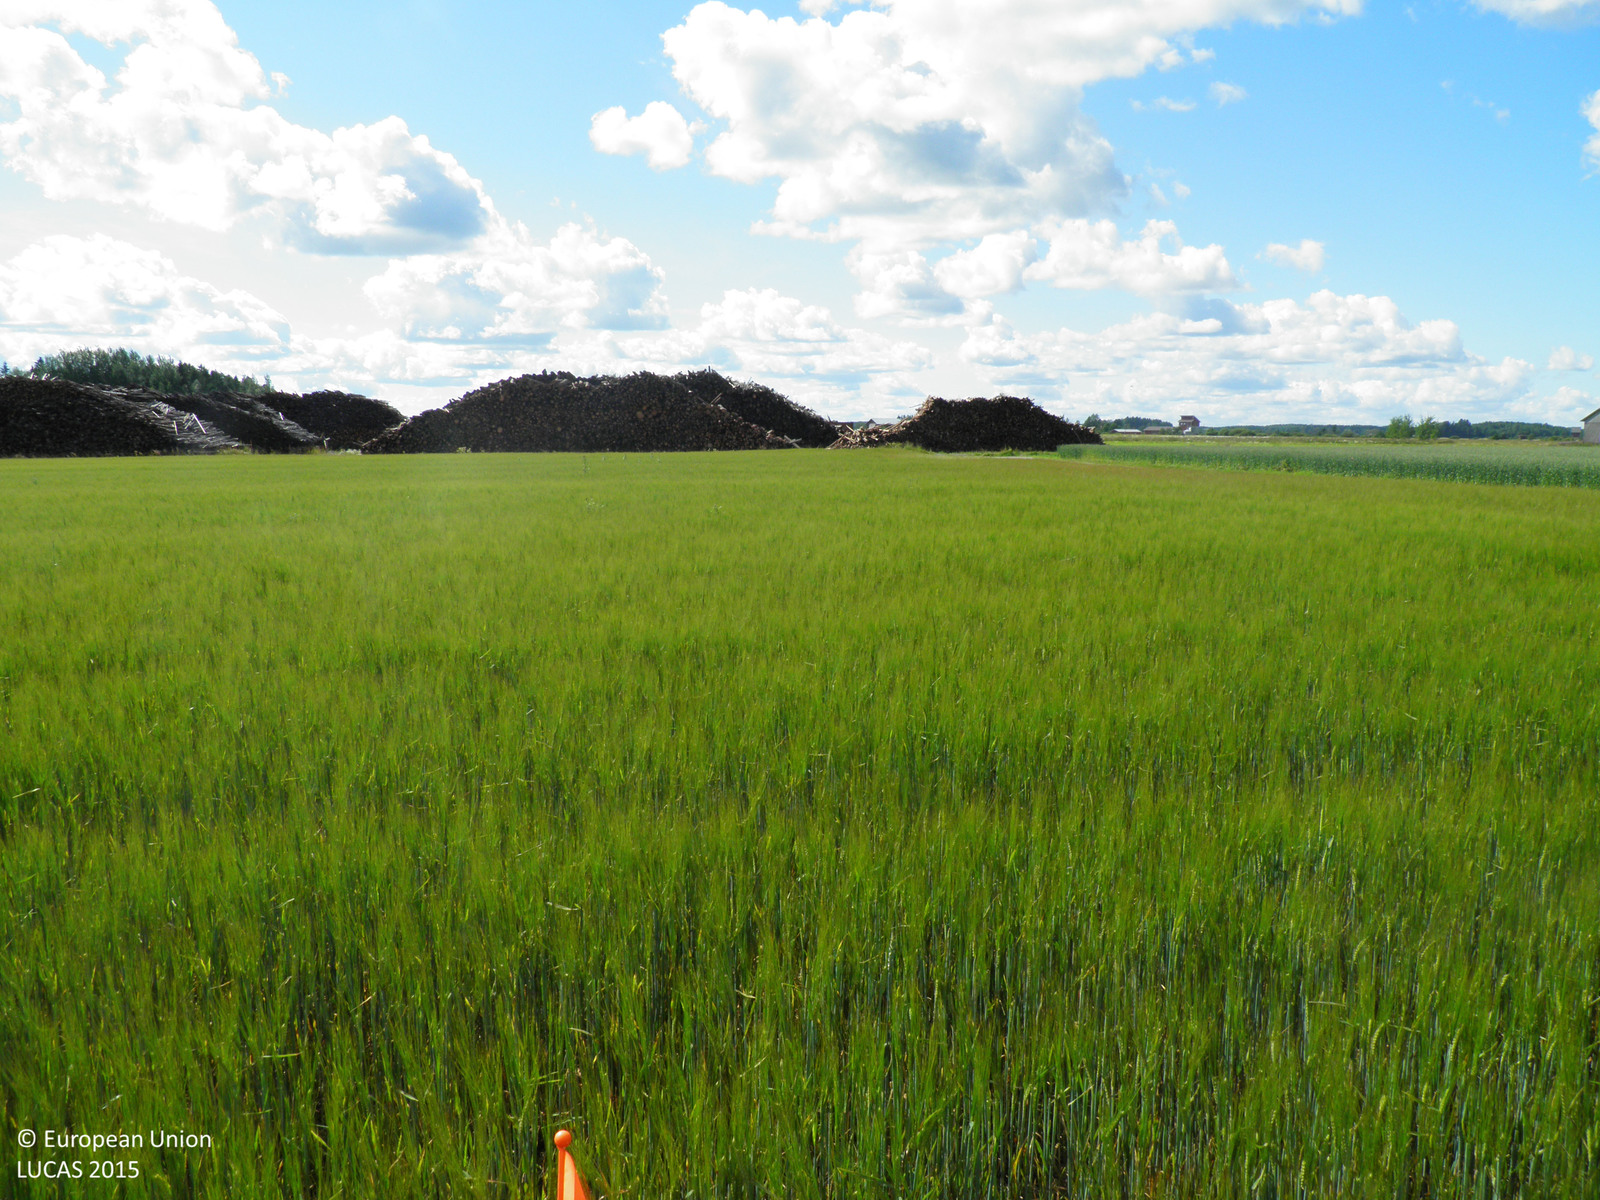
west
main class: Cropland
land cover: Barley
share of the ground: > 75 %
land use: Agriculture (excluding fallow land and kitchen gardens)
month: August
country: FI
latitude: 60.9492
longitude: 22.9792
